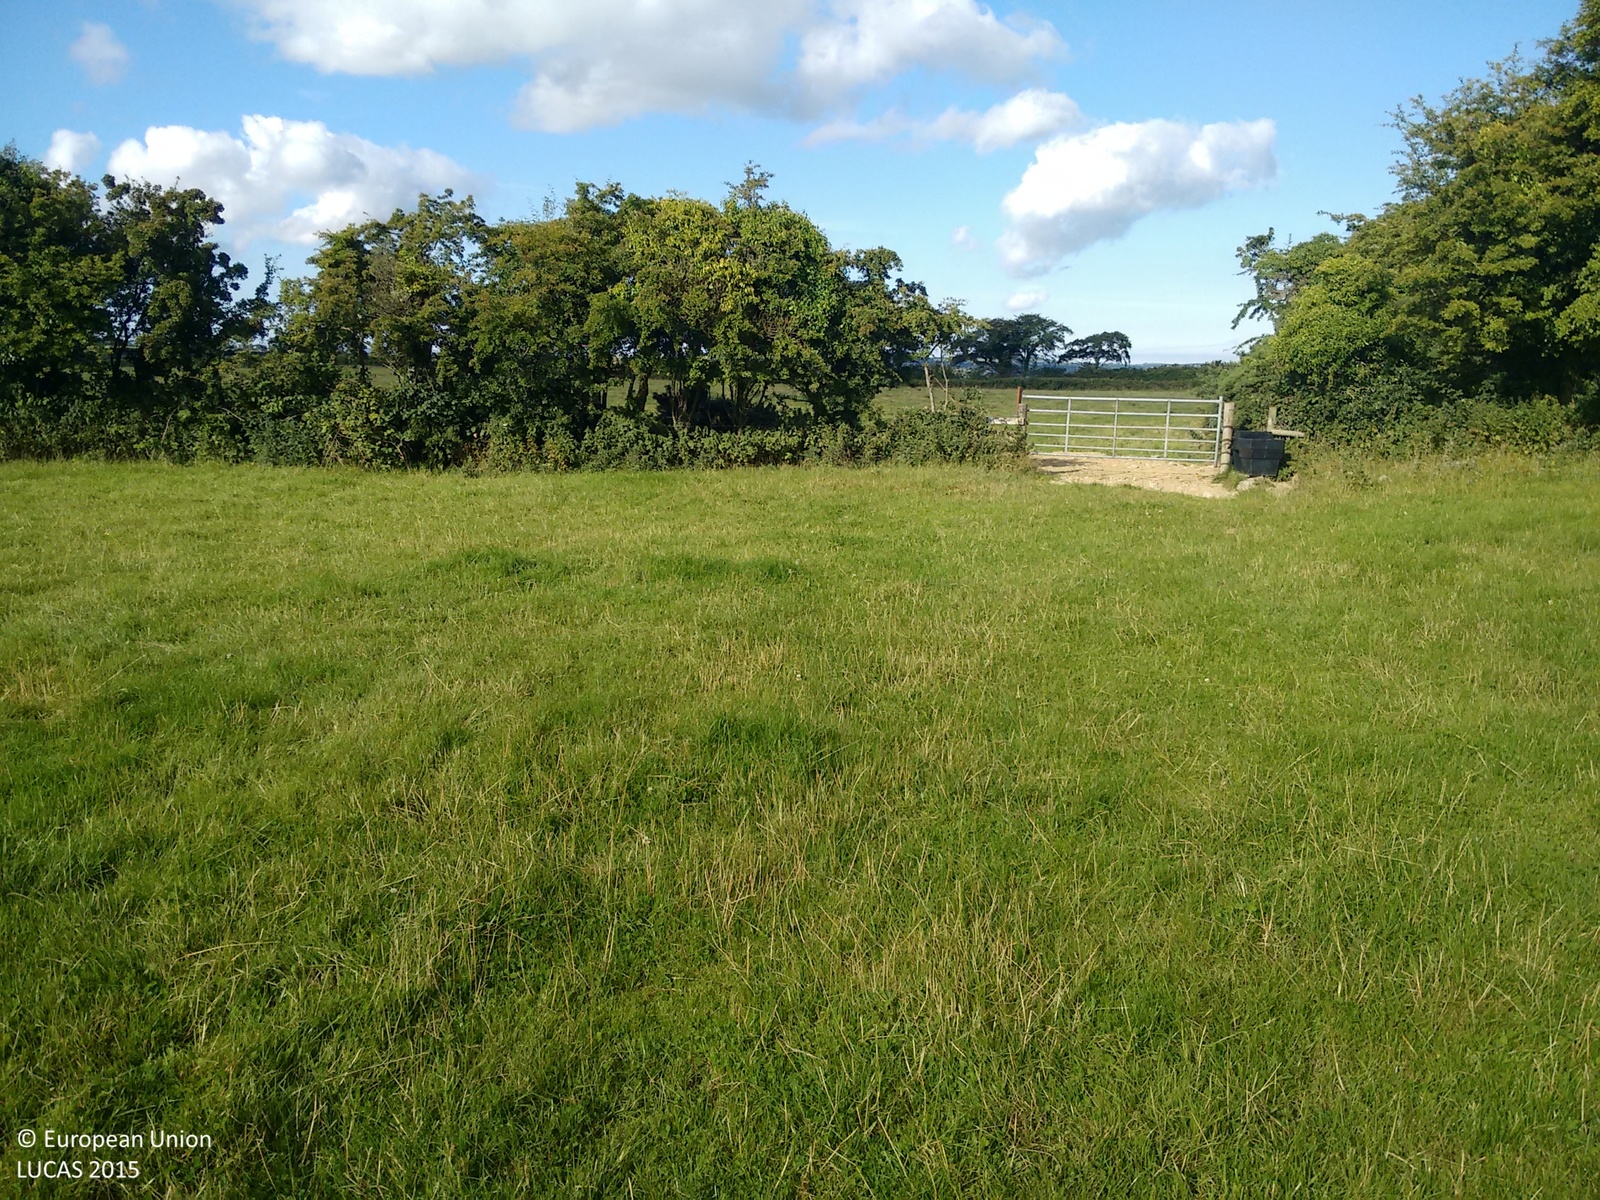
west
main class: Grassland
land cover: Grassland without tree/shrub cover
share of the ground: > 75 %
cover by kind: herbaceous plants 100 %
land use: Agriculture (excluding fallow land and kitchen gardens)
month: August
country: IE
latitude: 53.7785
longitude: -6.4063
